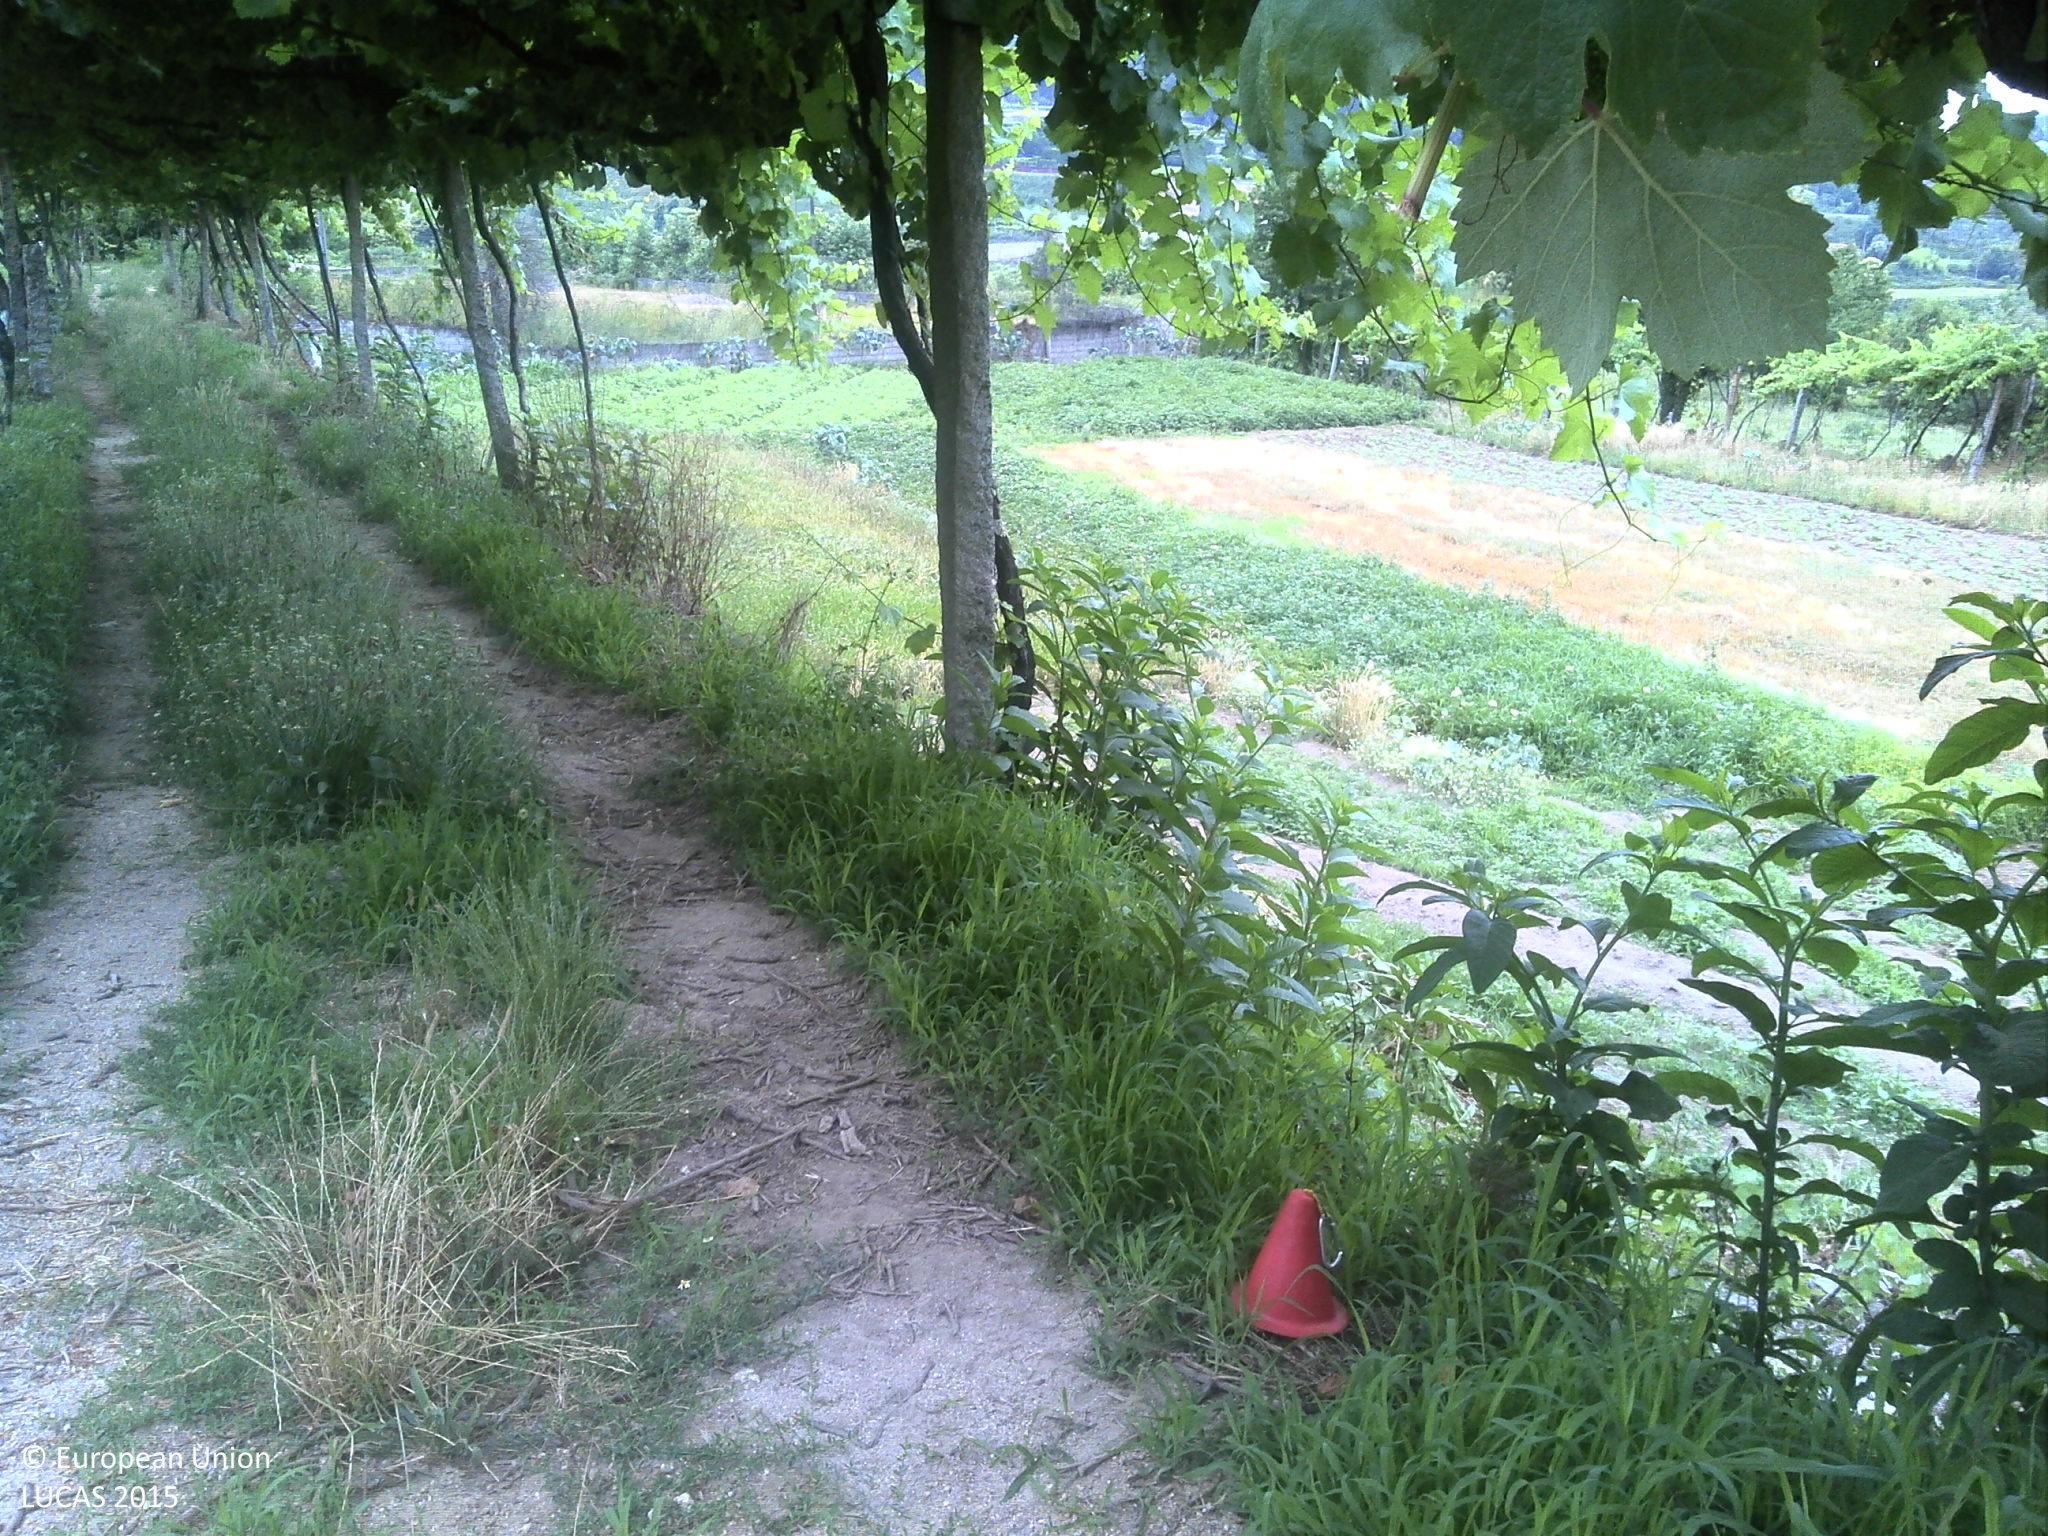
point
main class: Cropland
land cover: Vineyards
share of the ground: > 75 %
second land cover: Grassland without tree/shrub cover
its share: 10 - 25 %
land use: Agriculture (excluding fallow land and kitchen gardens)
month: June
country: PT
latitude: 41.2258
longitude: -8.2152
